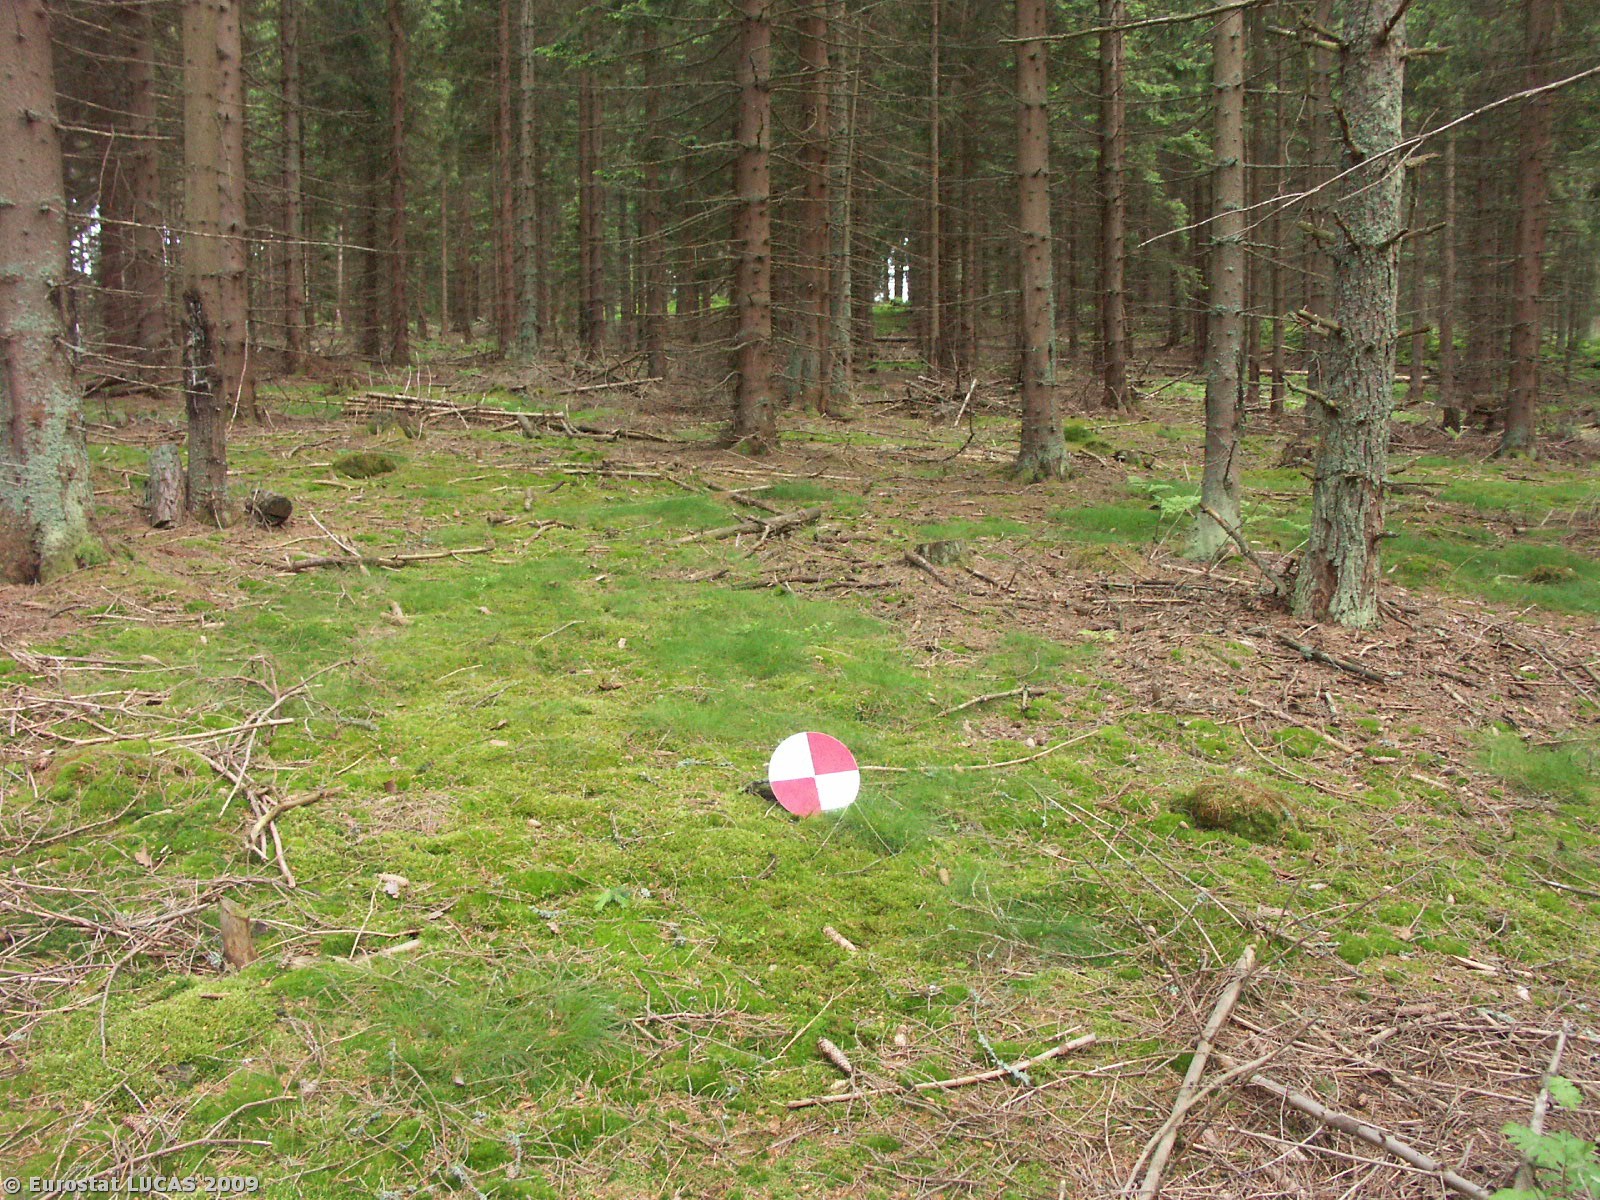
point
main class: Woodland
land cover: Coniferous woodland
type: hemiboreal forest and nemoral coniferous forest and mixed broadleaved-coniferous forest
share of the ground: > 75 %
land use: Forestry
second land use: Nature reserves
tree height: > 5 m
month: May
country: CZ
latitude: 48.9096
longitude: 13.9434
